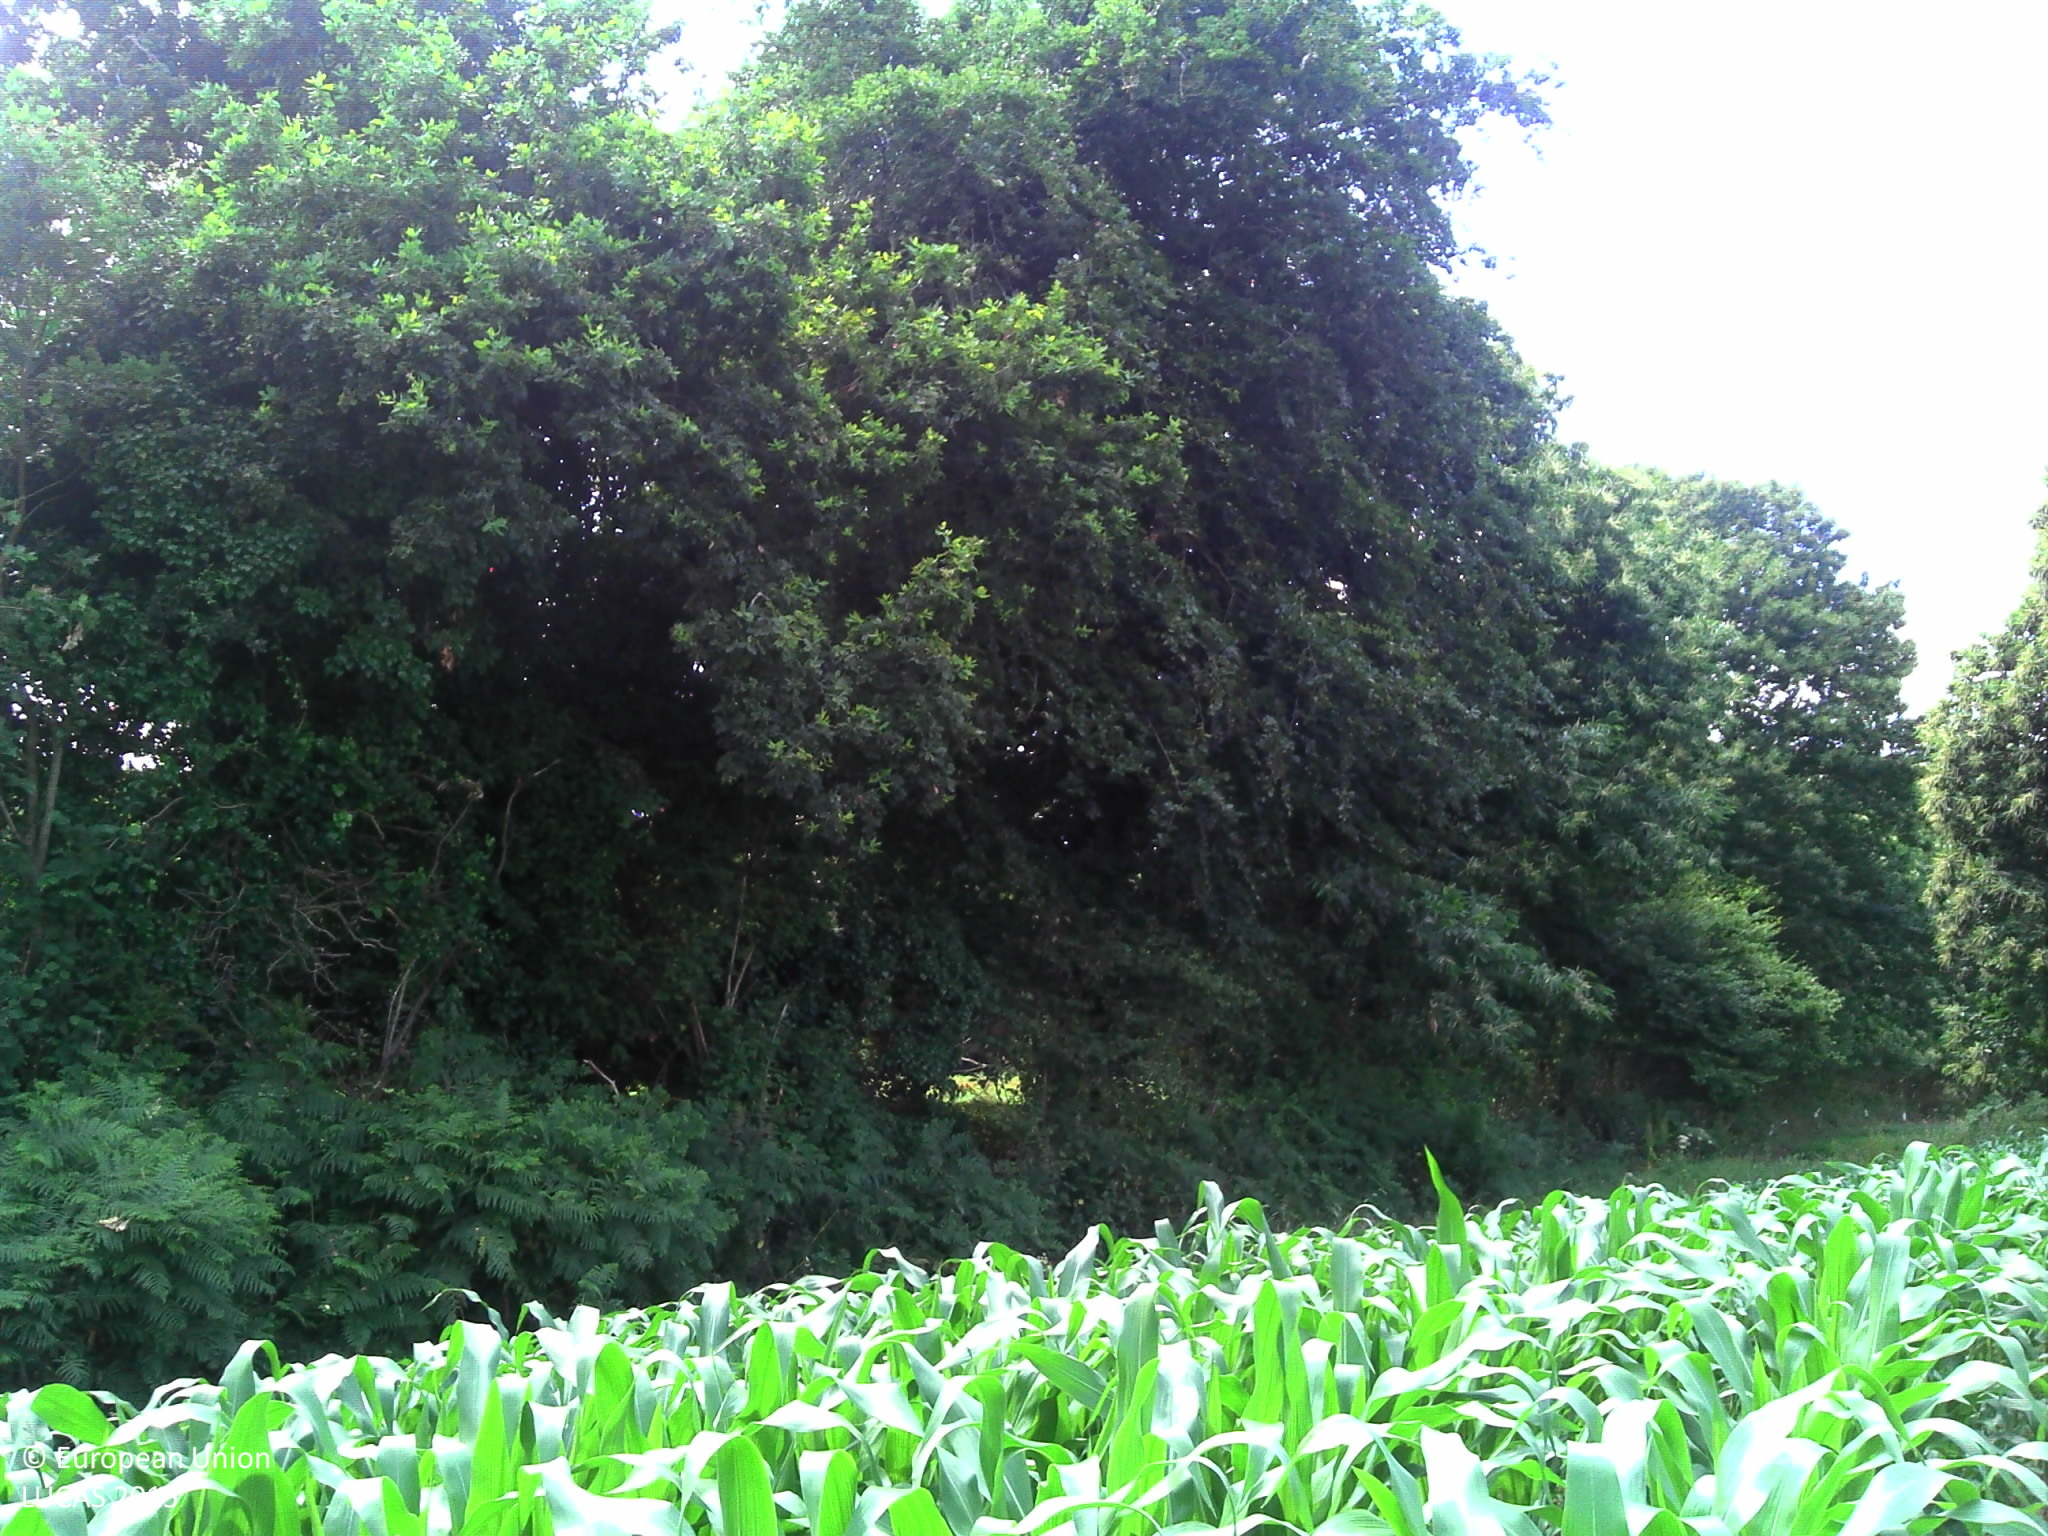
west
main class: Cropland
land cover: Maize
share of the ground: > 75 %
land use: Agriculture (excluding fallow land and kitchen gardens)
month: July
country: FR
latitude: 48.6323
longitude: -3.4716
